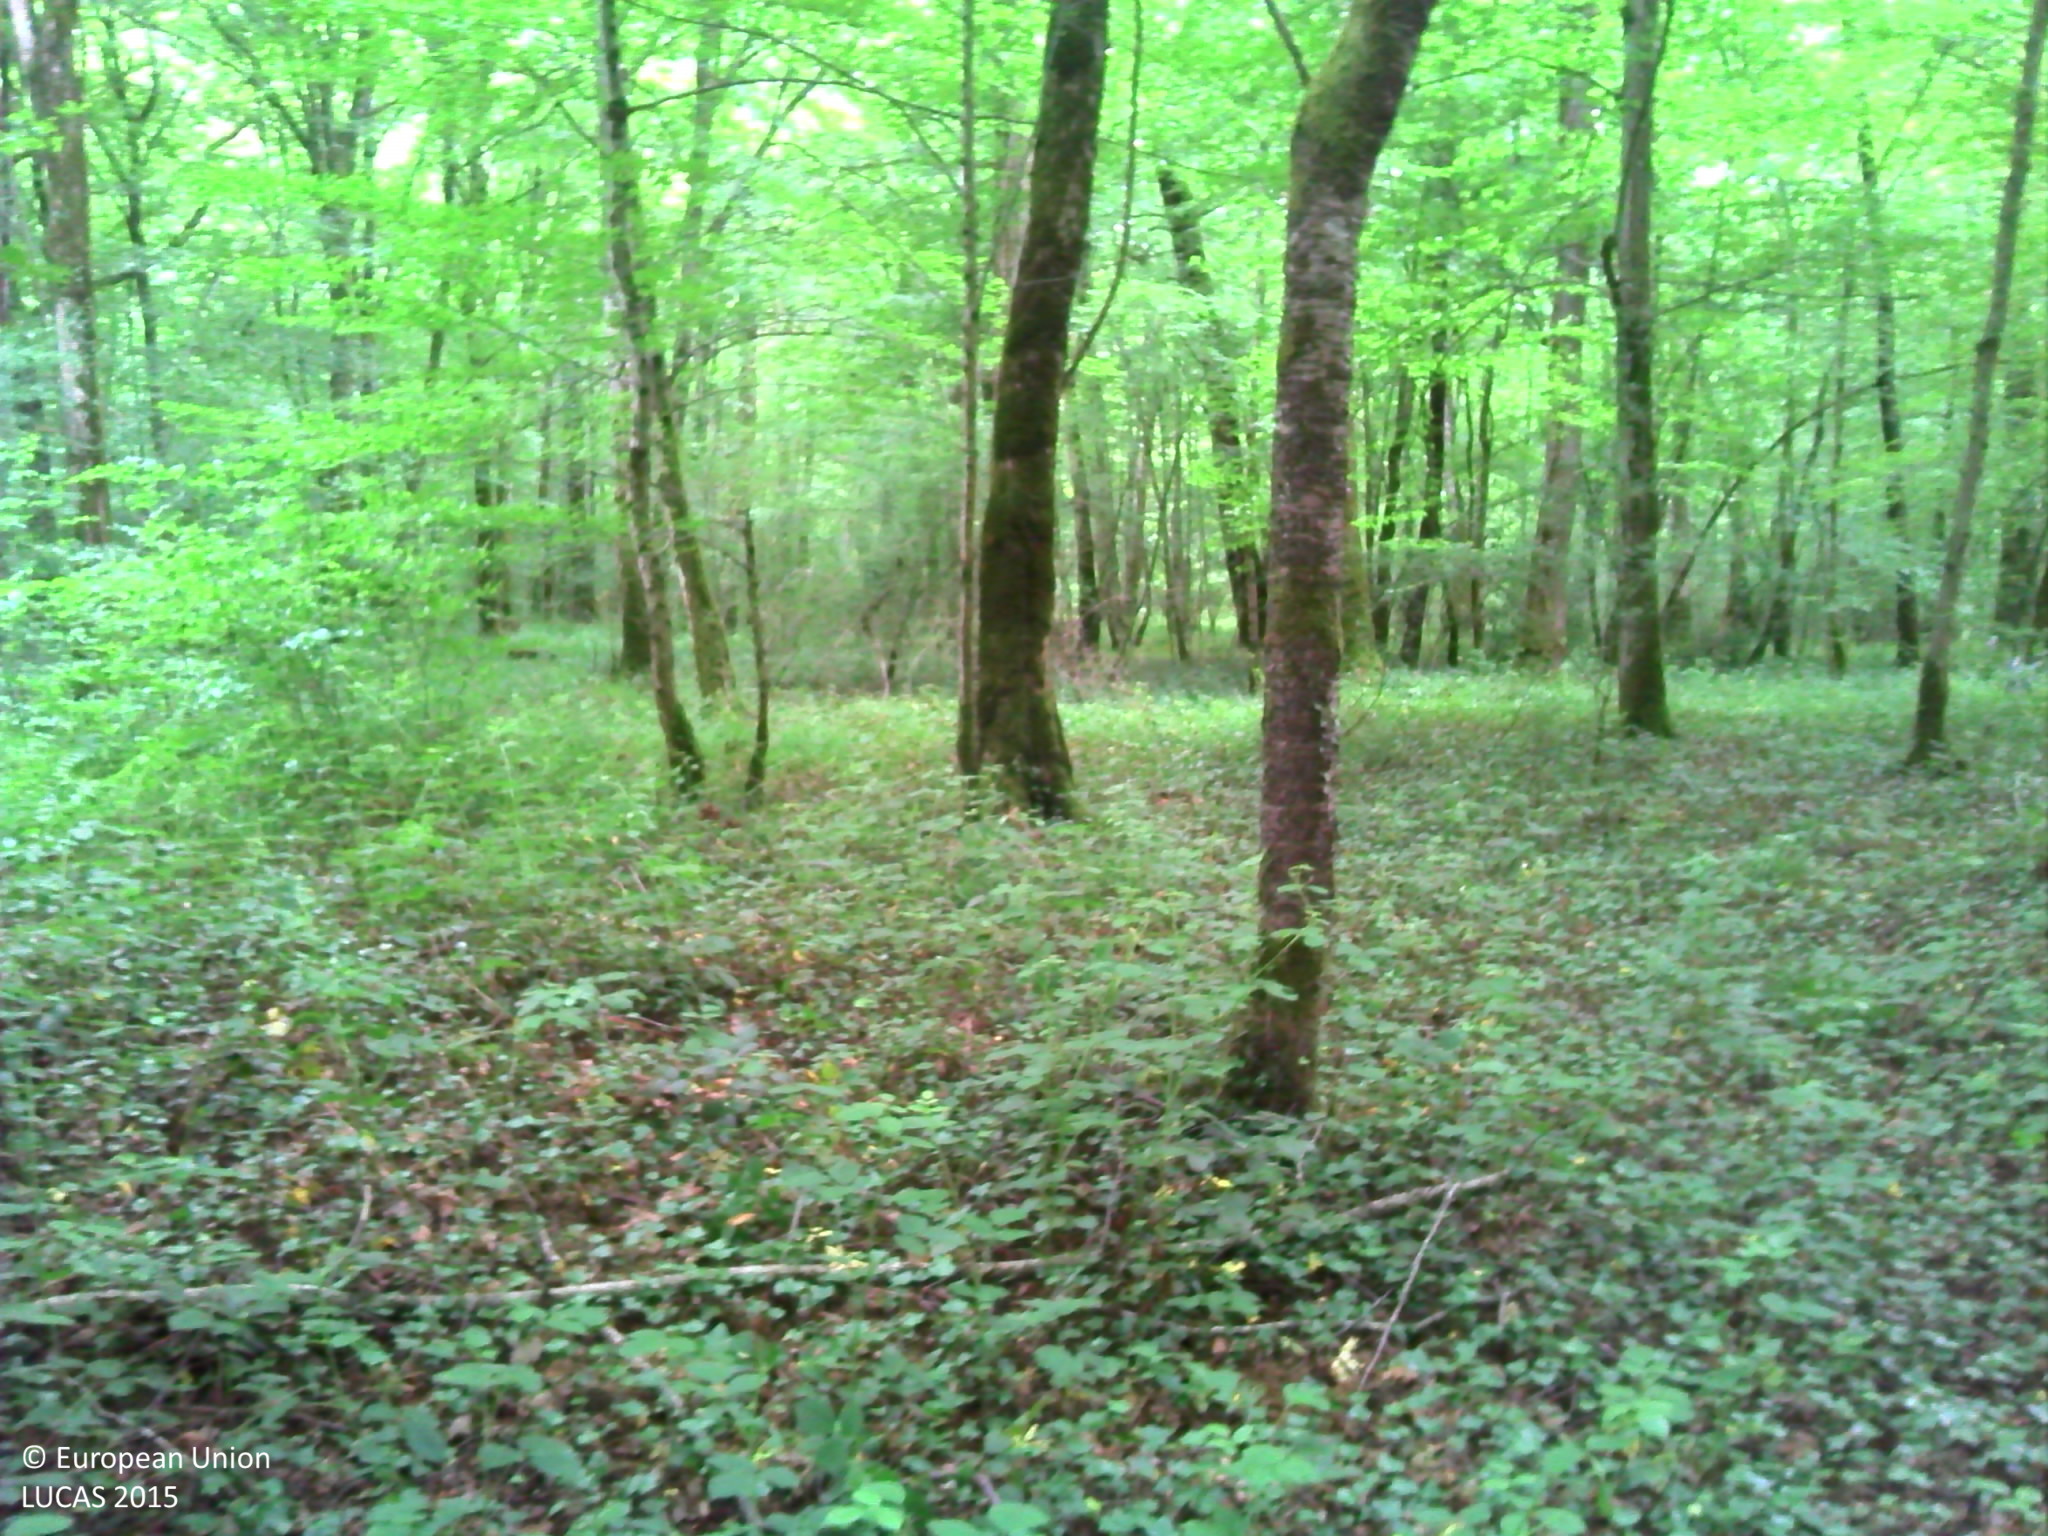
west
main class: Woodland
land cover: Broadleaved woodland
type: beech forest
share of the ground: > 75 %
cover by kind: broadleaved forest trees 95 %, herbaceous plants 5 %
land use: Forestry
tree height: > 5 m
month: June
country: FR
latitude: 47.5685
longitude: 6.3460
